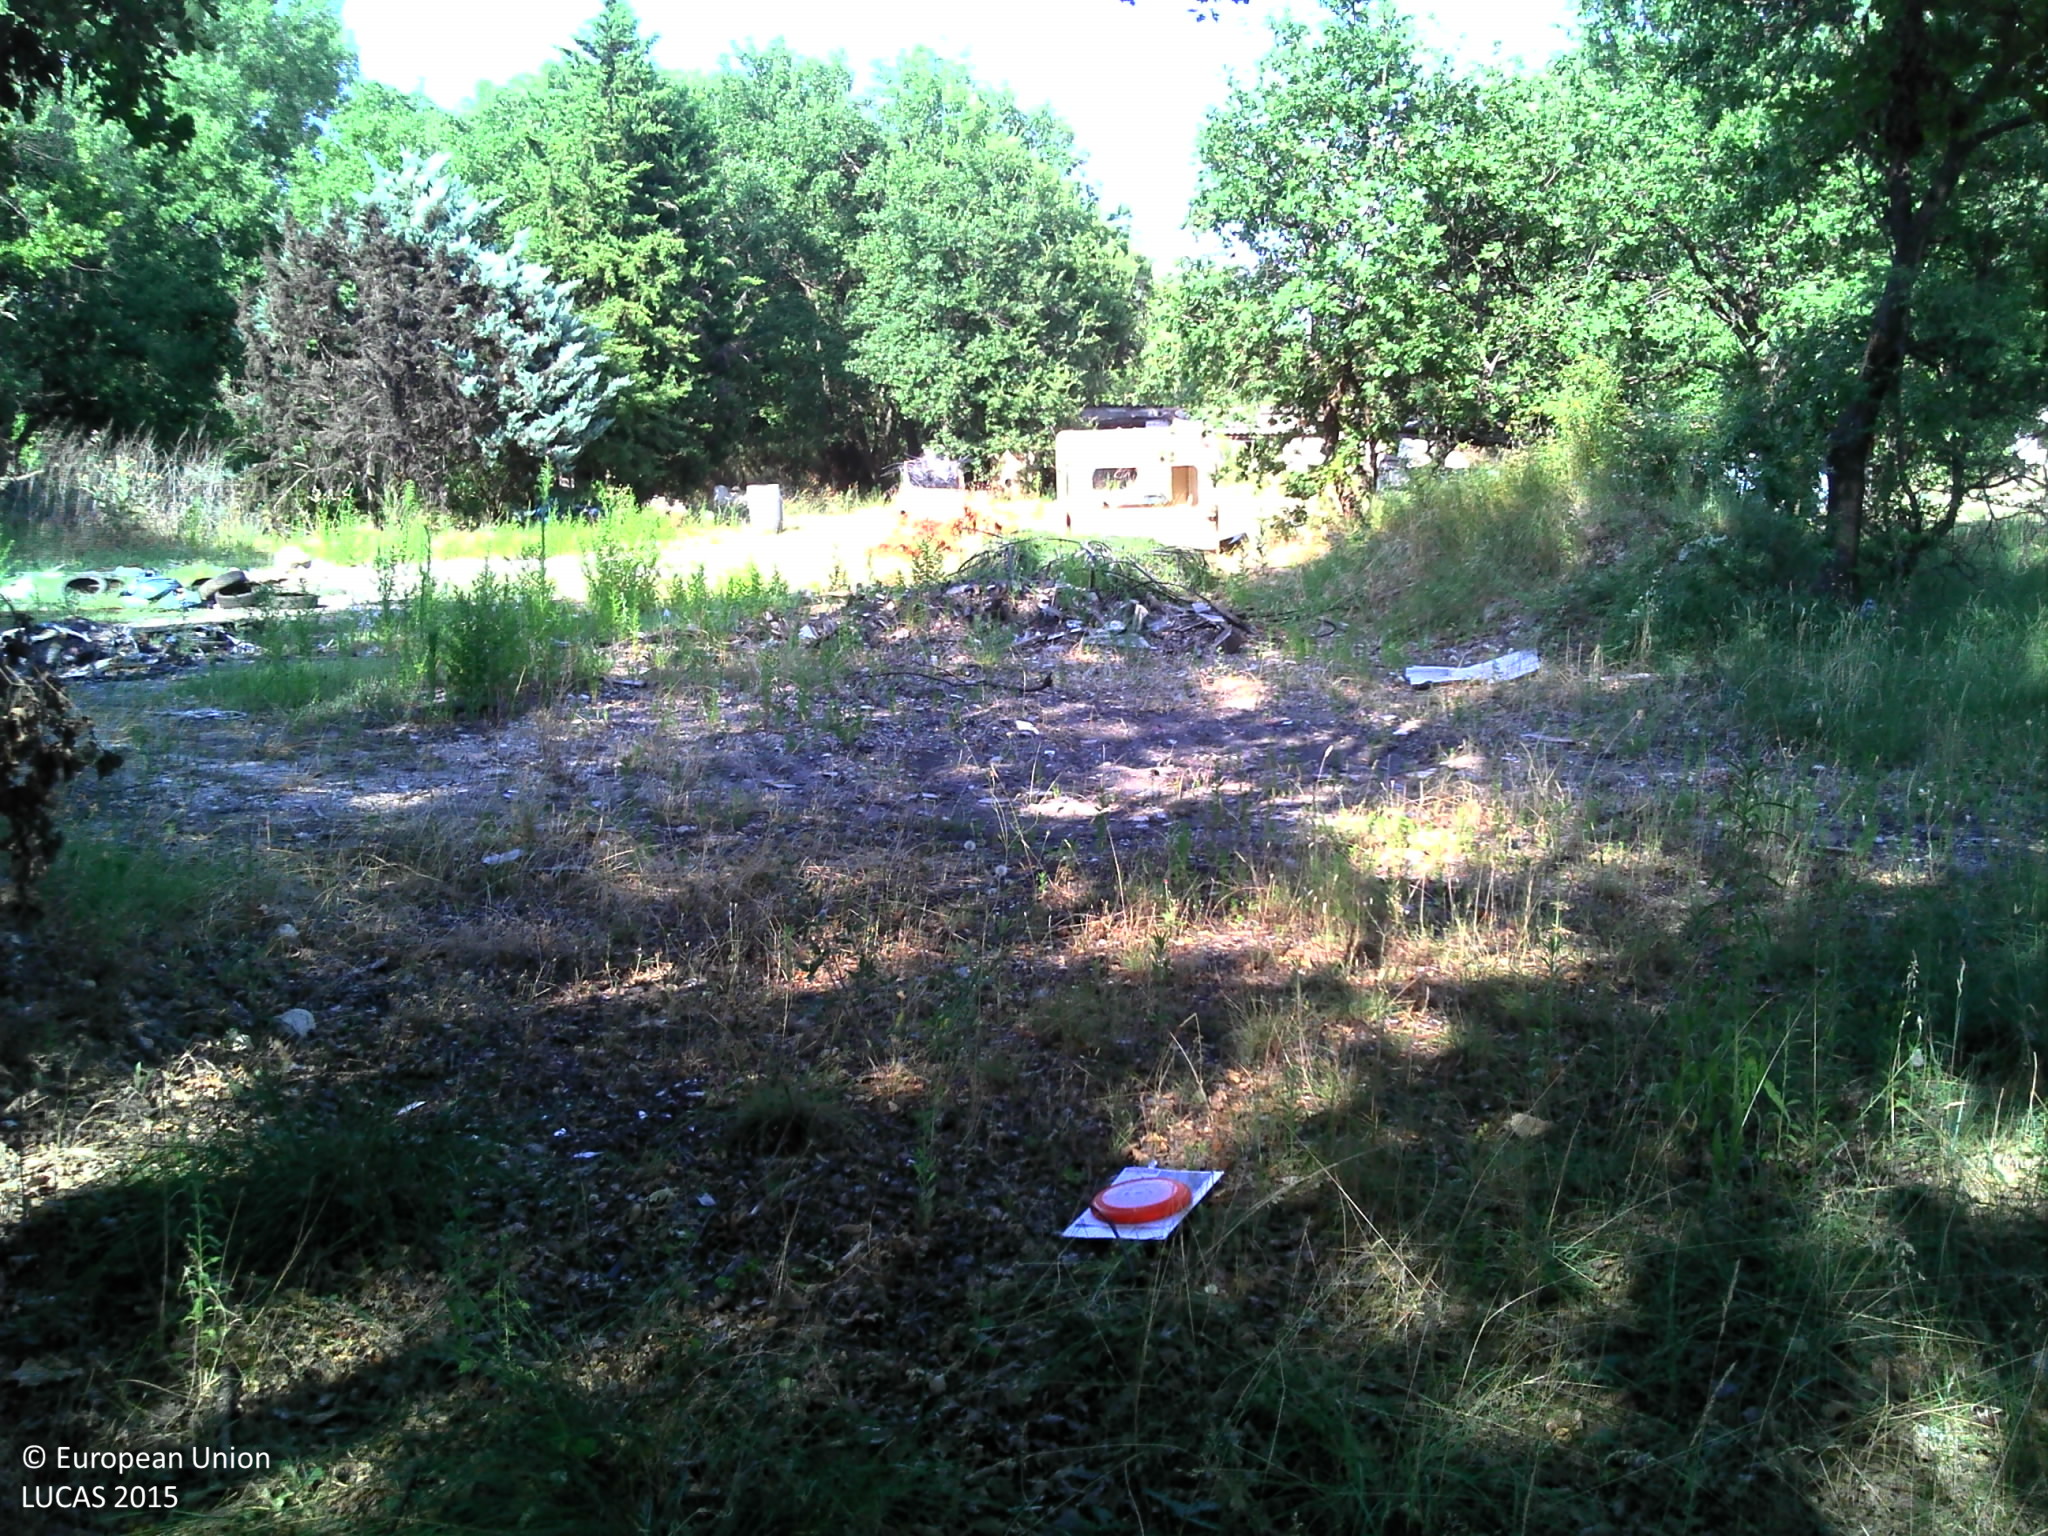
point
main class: Woodland
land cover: Broadleaved woodland
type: thermophilous deciduous forest
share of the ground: > 75 %
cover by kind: broadleaved forest trees 60 %, herbaceous plants 20 %, unconsolidated bare surface 10 %, coniferous forest trees 5 %, shrubs 5 %
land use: Forestry
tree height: > 5 m
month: October
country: FR
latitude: 44.0903
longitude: 5.0997
